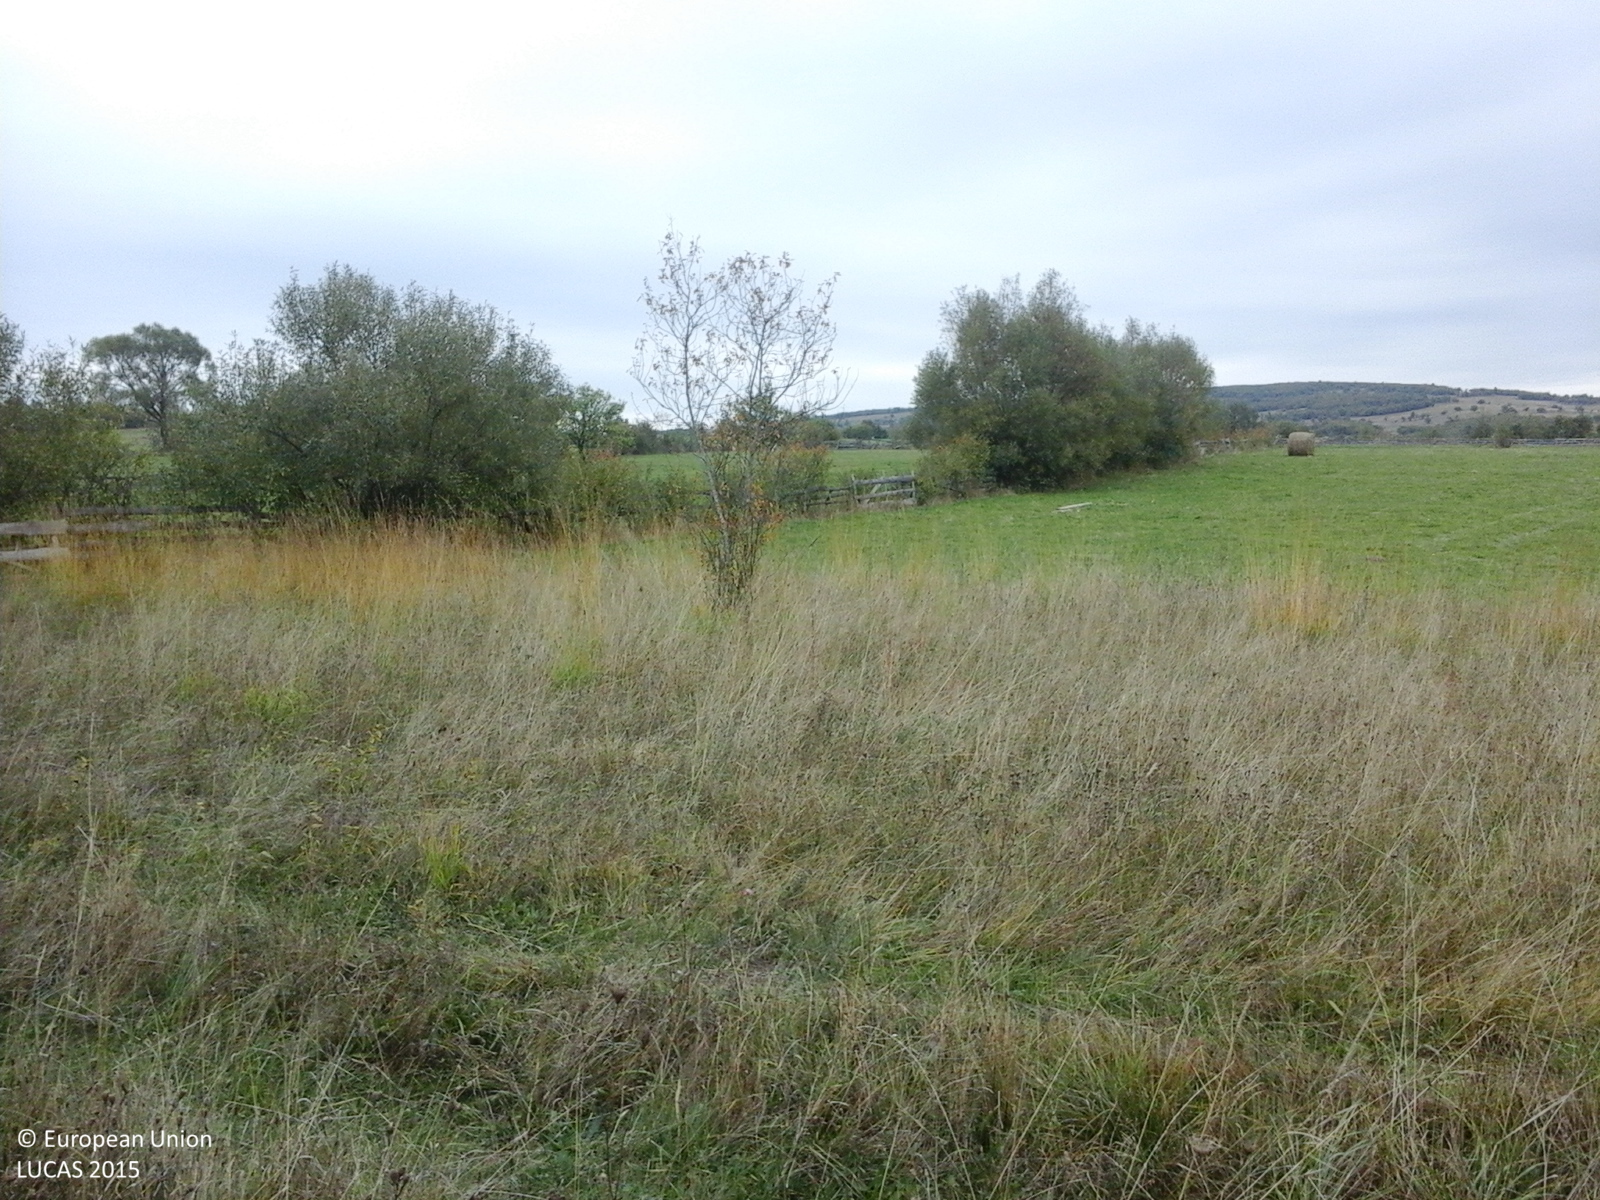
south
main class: Grassland
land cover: Spontaneously vegetated surfaces
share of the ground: > 75 %
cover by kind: herbaceous plants 100 %
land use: Fallow land
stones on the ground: < 10 %
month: October
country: RO
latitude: 46.7424
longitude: 24.9268
